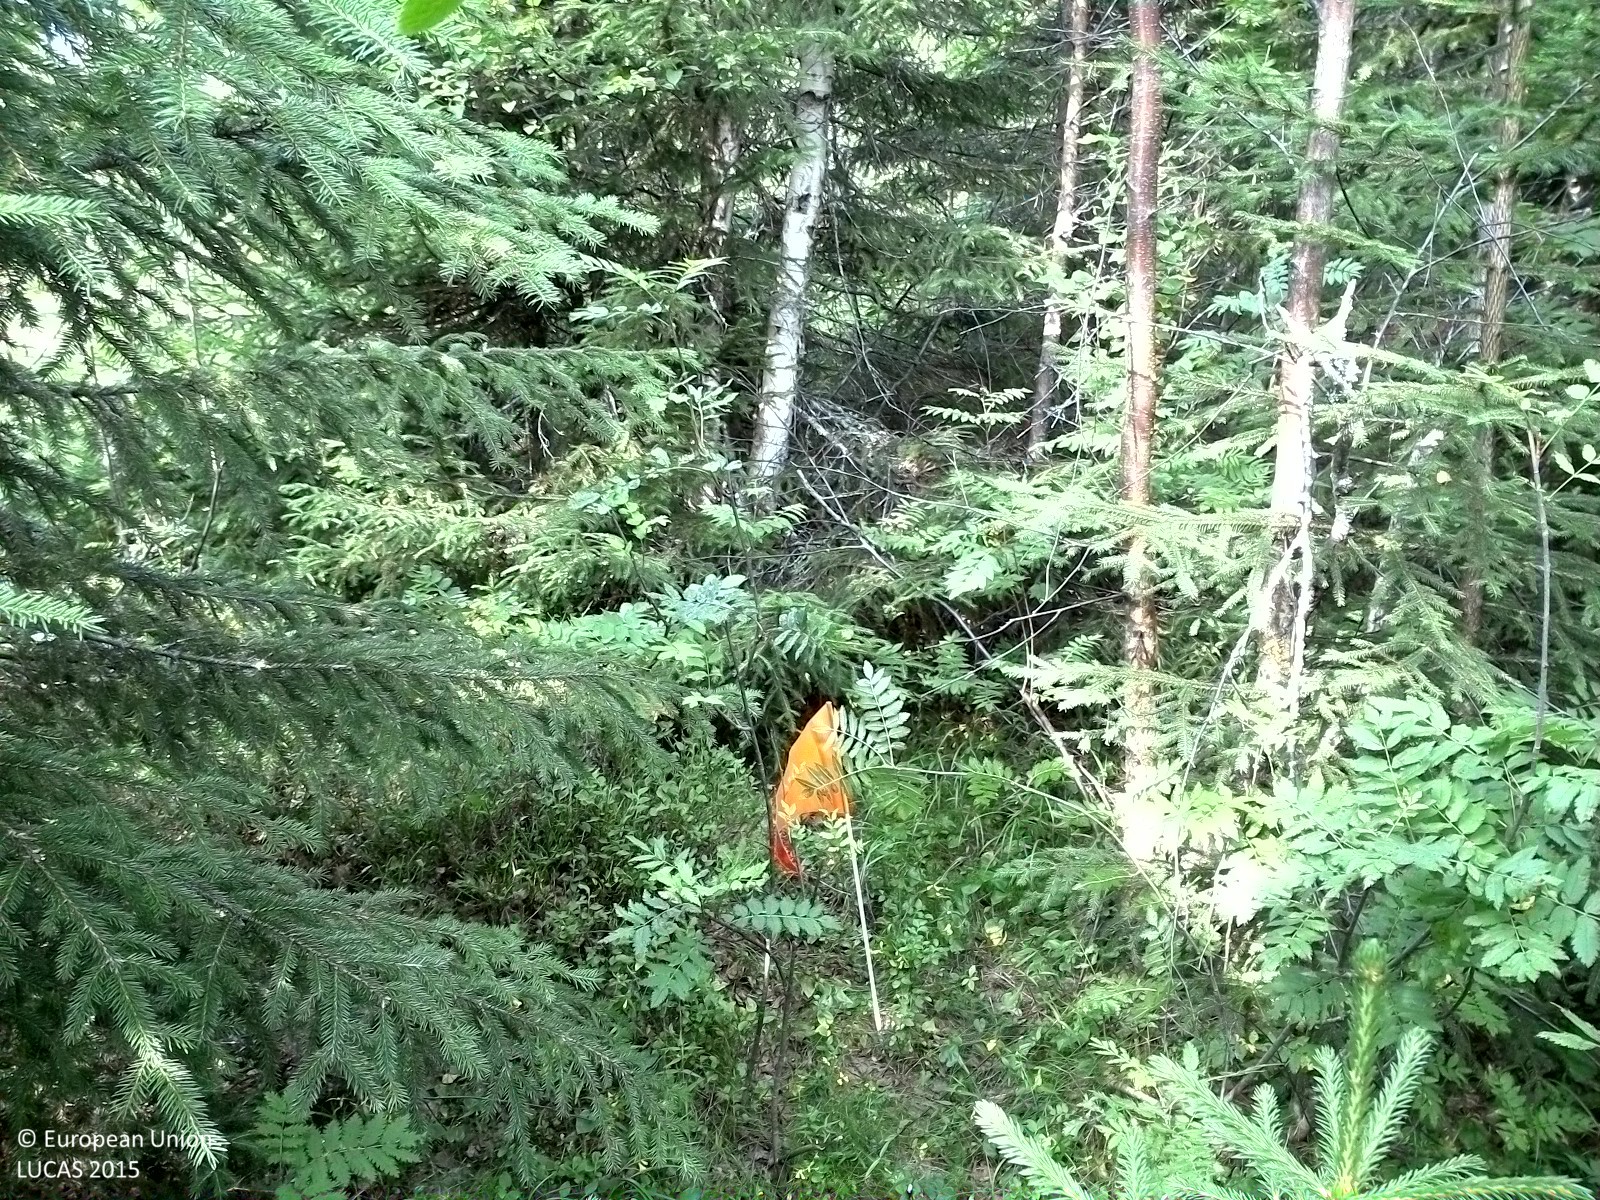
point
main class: Woodland
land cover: Other mixed woodland
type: boreal forest
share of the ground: > 75 %
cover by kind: broadleaved forest trees 50 %, coniferous forest trees 30 %, herbaceous plants 15 %, shrubs 5 %
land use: Forestry
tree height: > 5 m
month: August
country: SE
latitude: 62.3663
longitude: 17.2278
